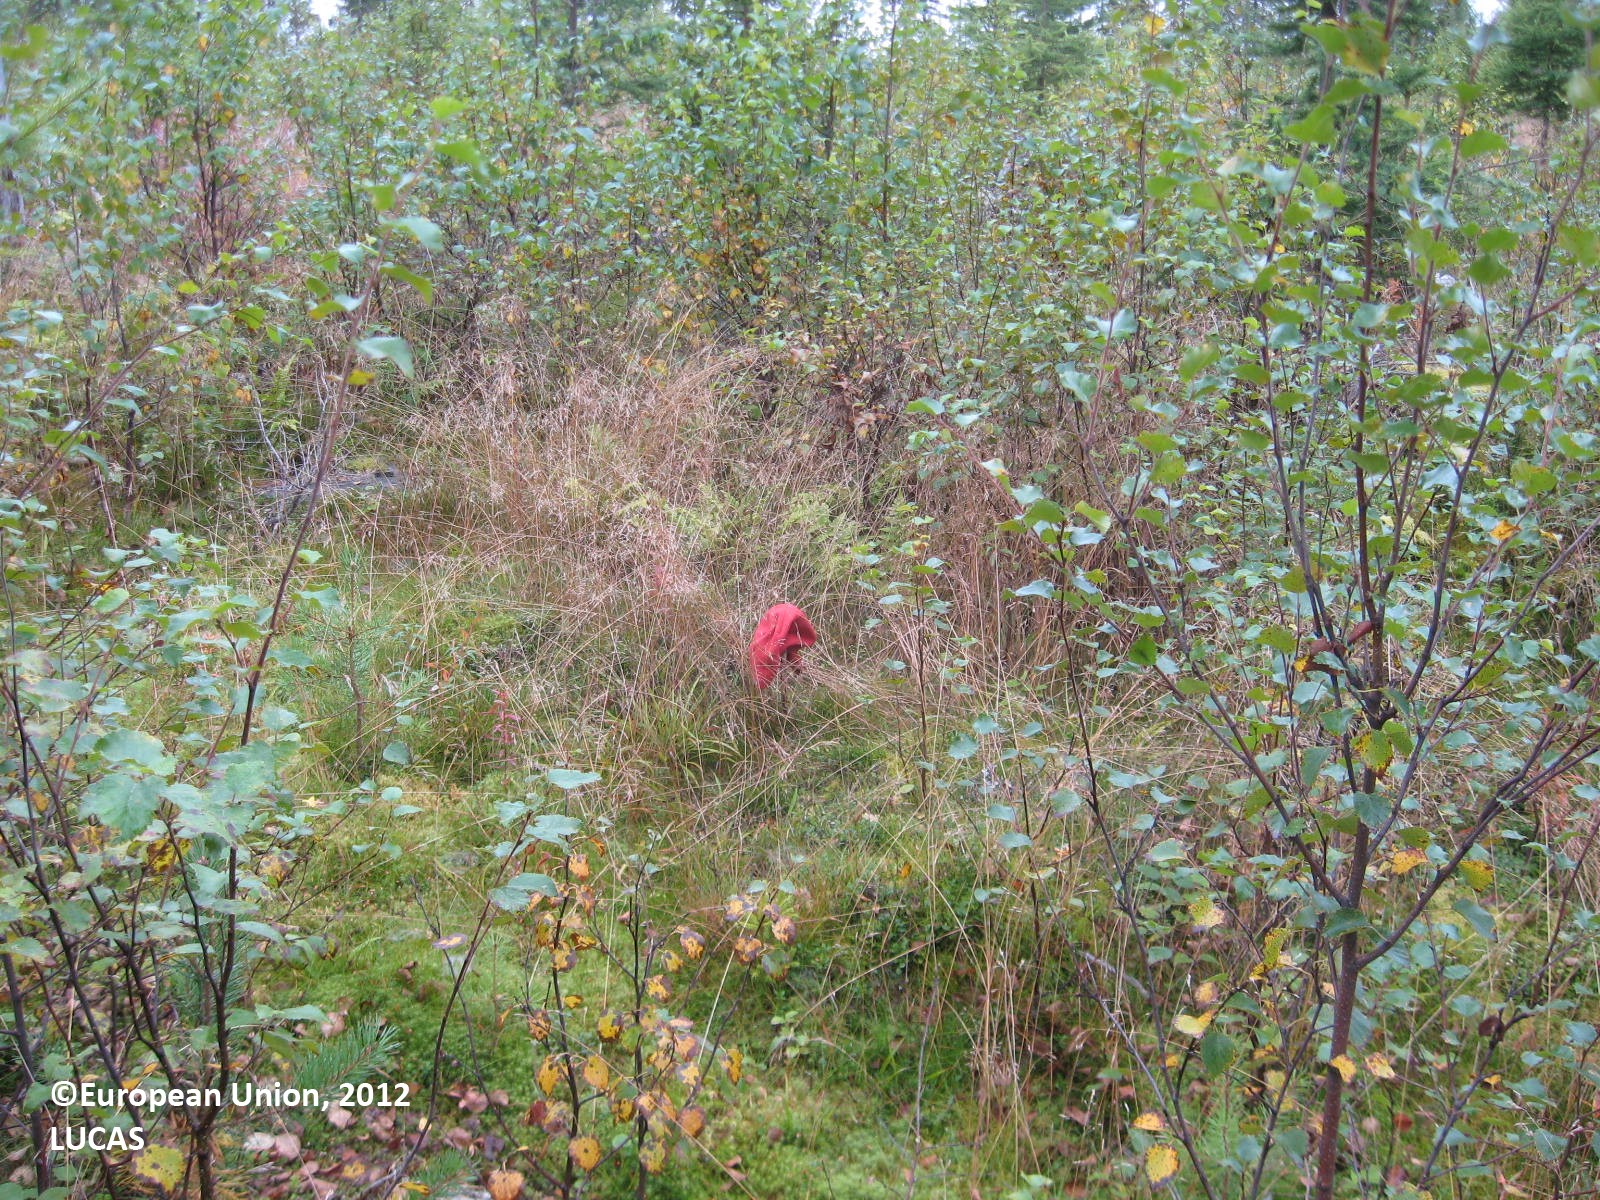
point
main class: Woodland
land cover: Other mixed woodland
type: boreal forest
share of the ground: > 75 %
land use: Forestry
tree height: < 5 m
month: August
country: FI
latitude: 63.8768
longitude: 29.6693
